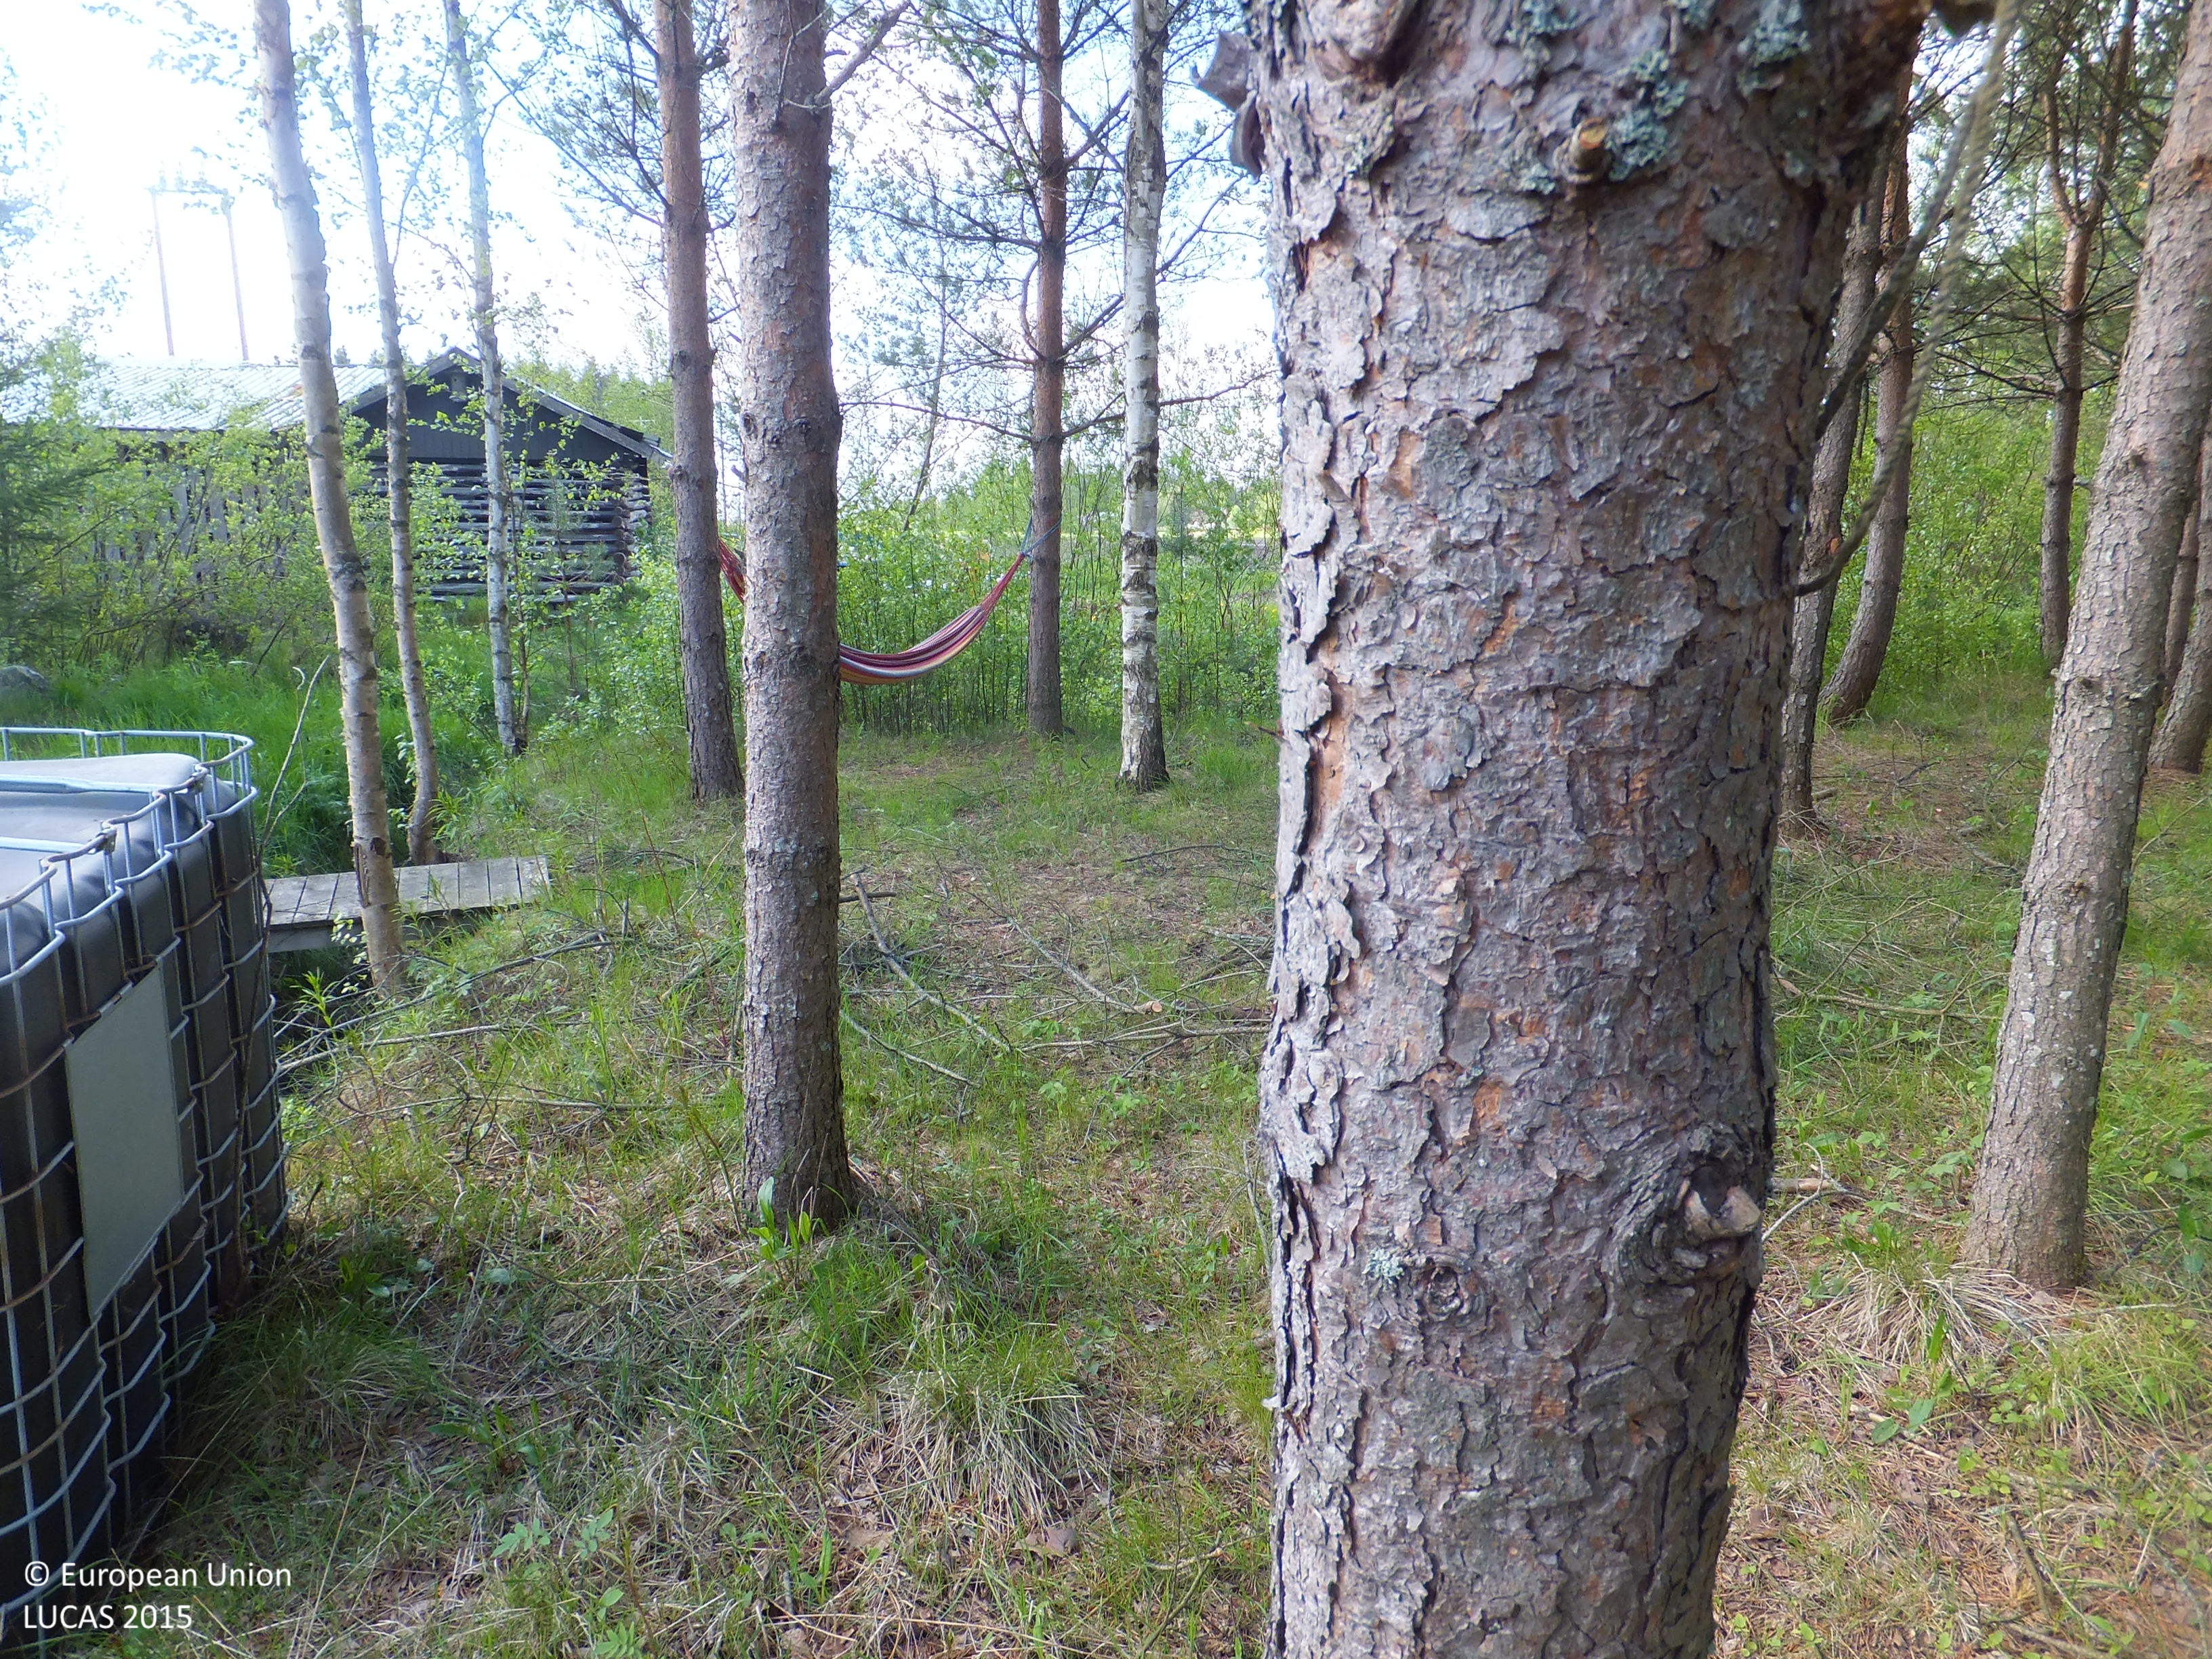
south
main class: Grassland
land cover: Grassland without tree/shrub cover
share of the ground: > 75 %
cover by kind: herbaceous plants 100 %
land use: Residential
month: June
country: FI
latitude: 63.5870
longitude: 22.7641
